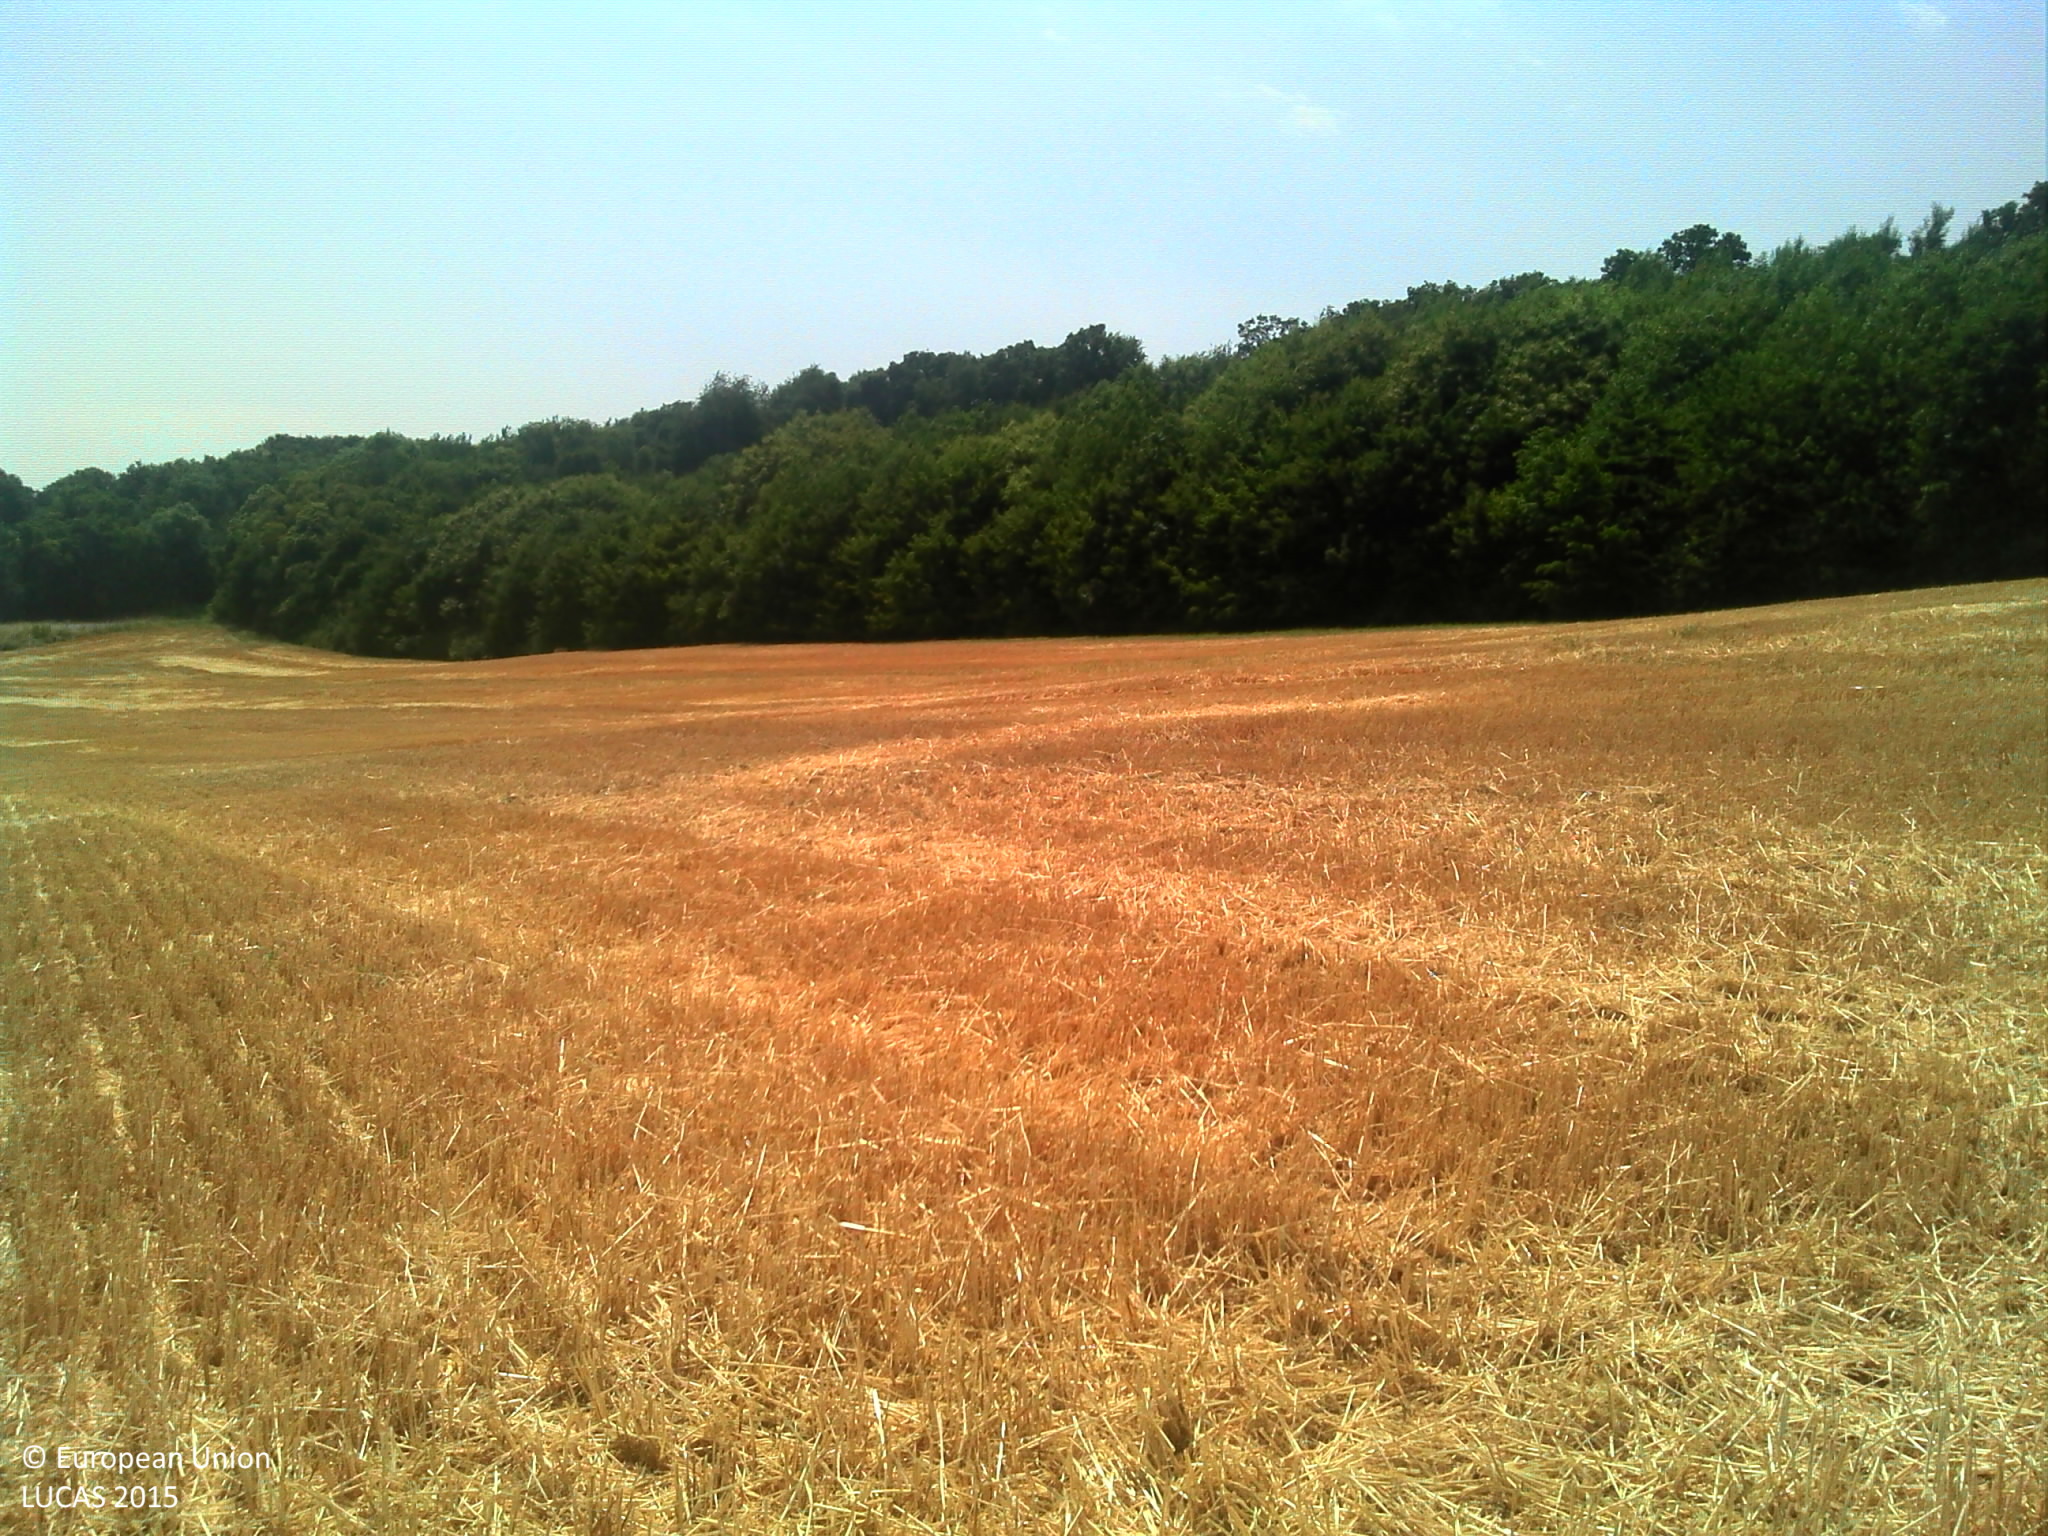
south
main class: Cropland
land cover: Barley
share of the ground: > 75 %
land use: Agriculture (excluding fallow land and kitchen gardens)
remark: Harvested field
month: July
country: FR
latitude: 48.7711
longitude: 1.3687
